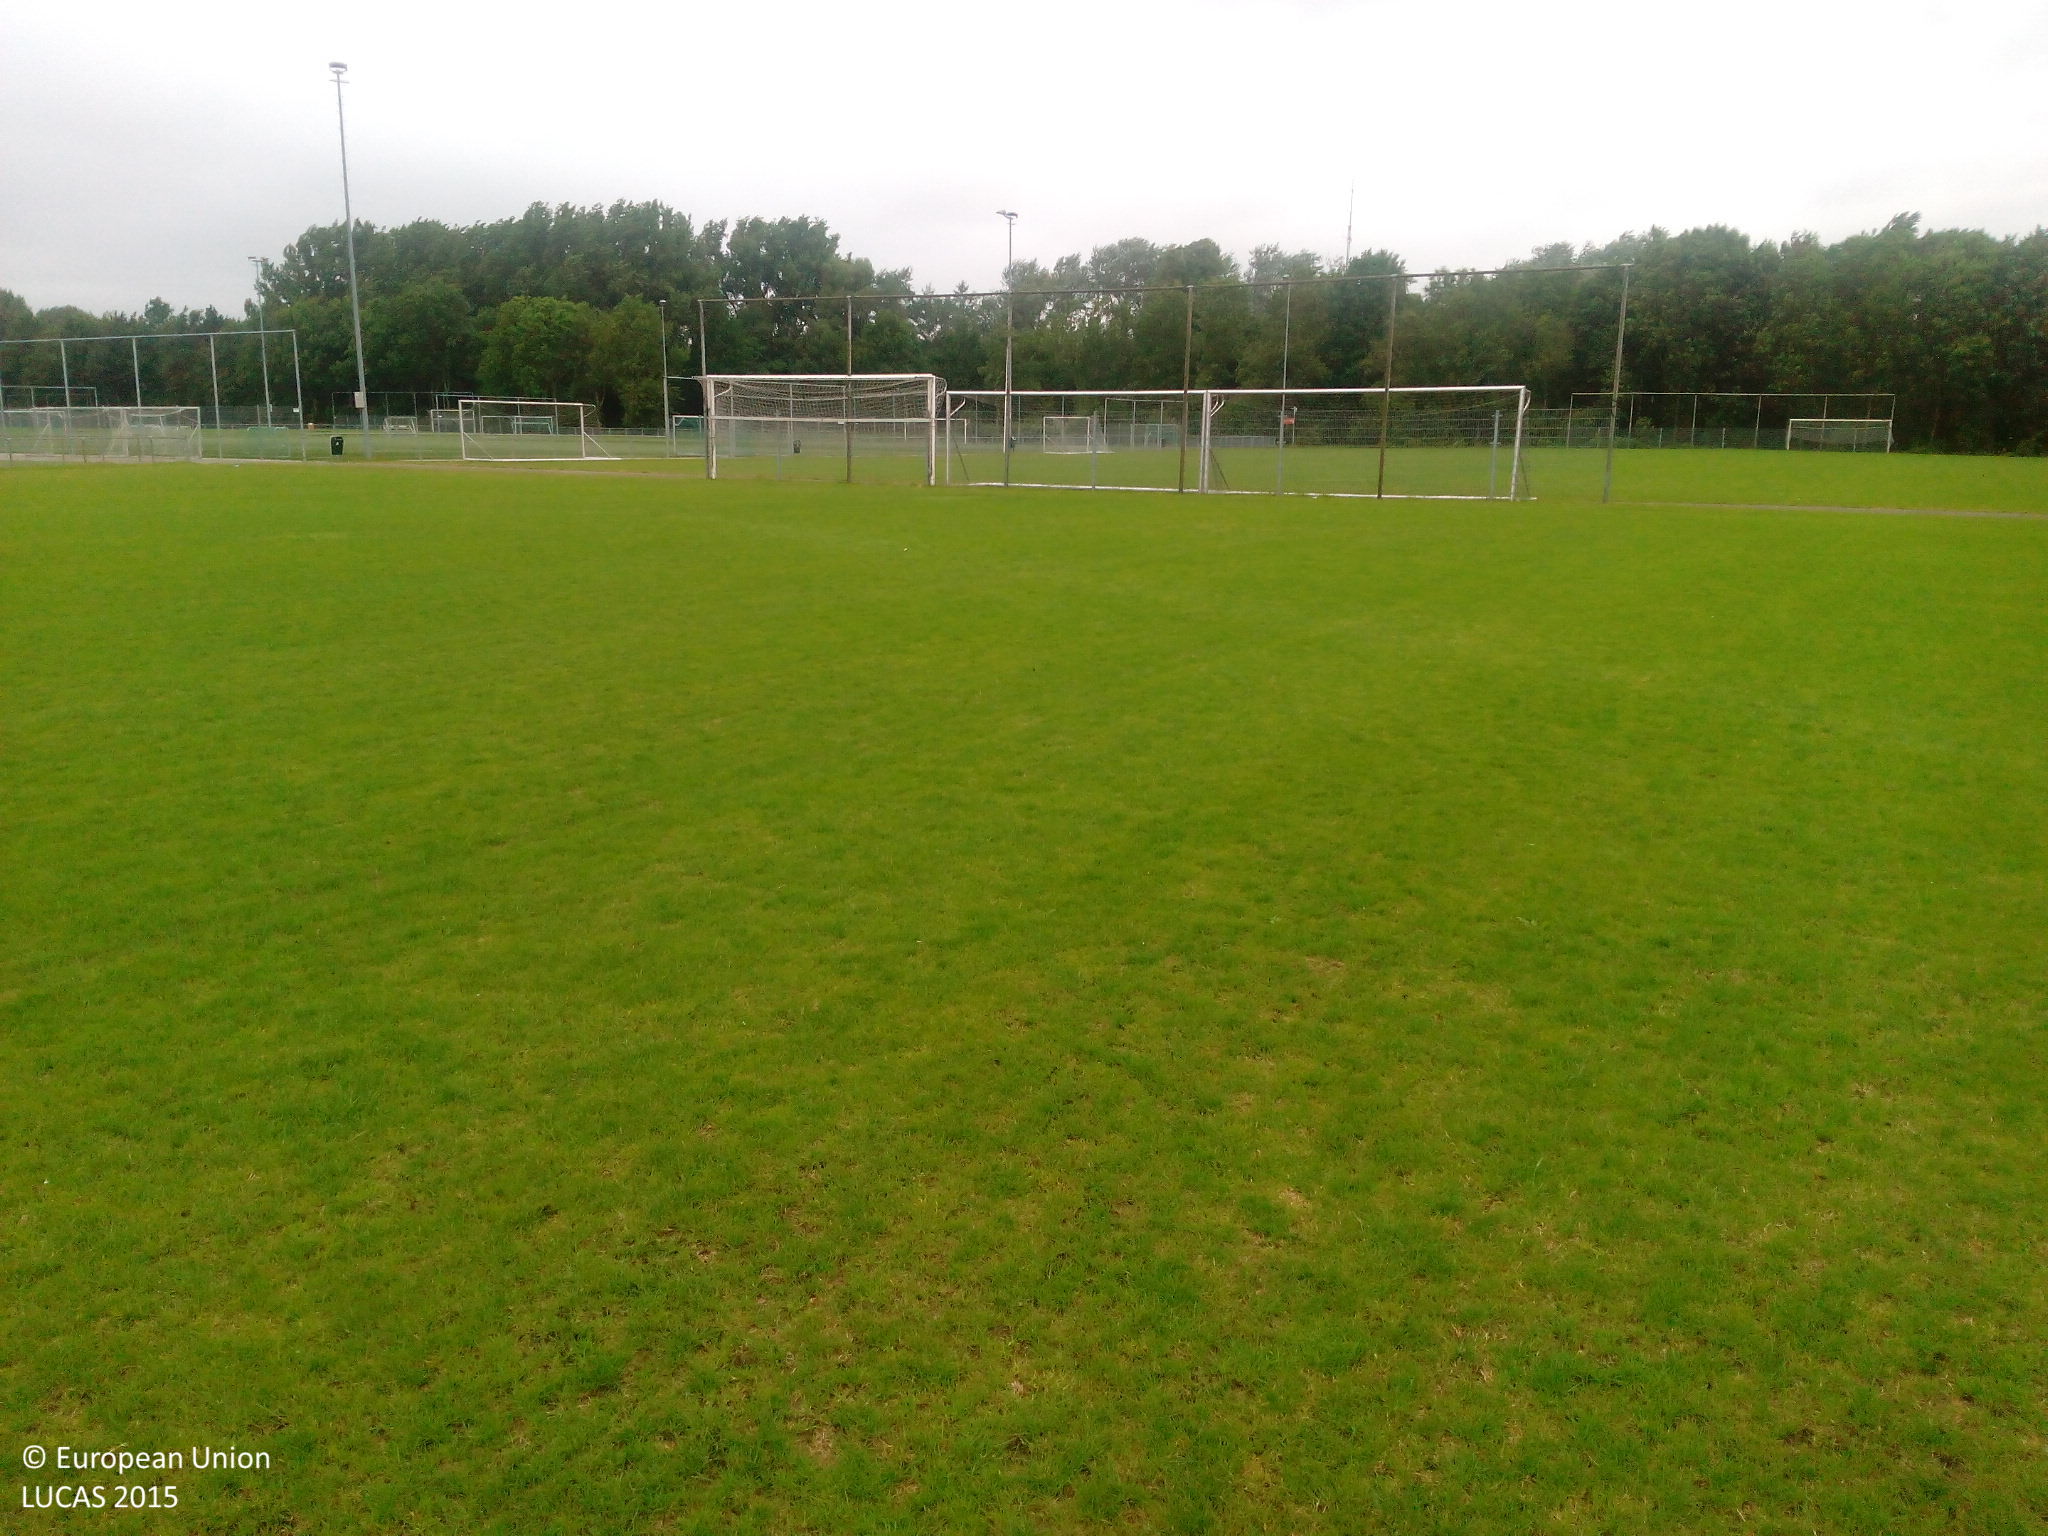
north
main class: Grassland
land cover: Grassland without tree/shrub cover
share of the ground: > 75 %
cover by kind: herbaceous plants 100 %
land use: Sport
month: June
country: NL
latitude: 51.8089
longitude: 4.7025
